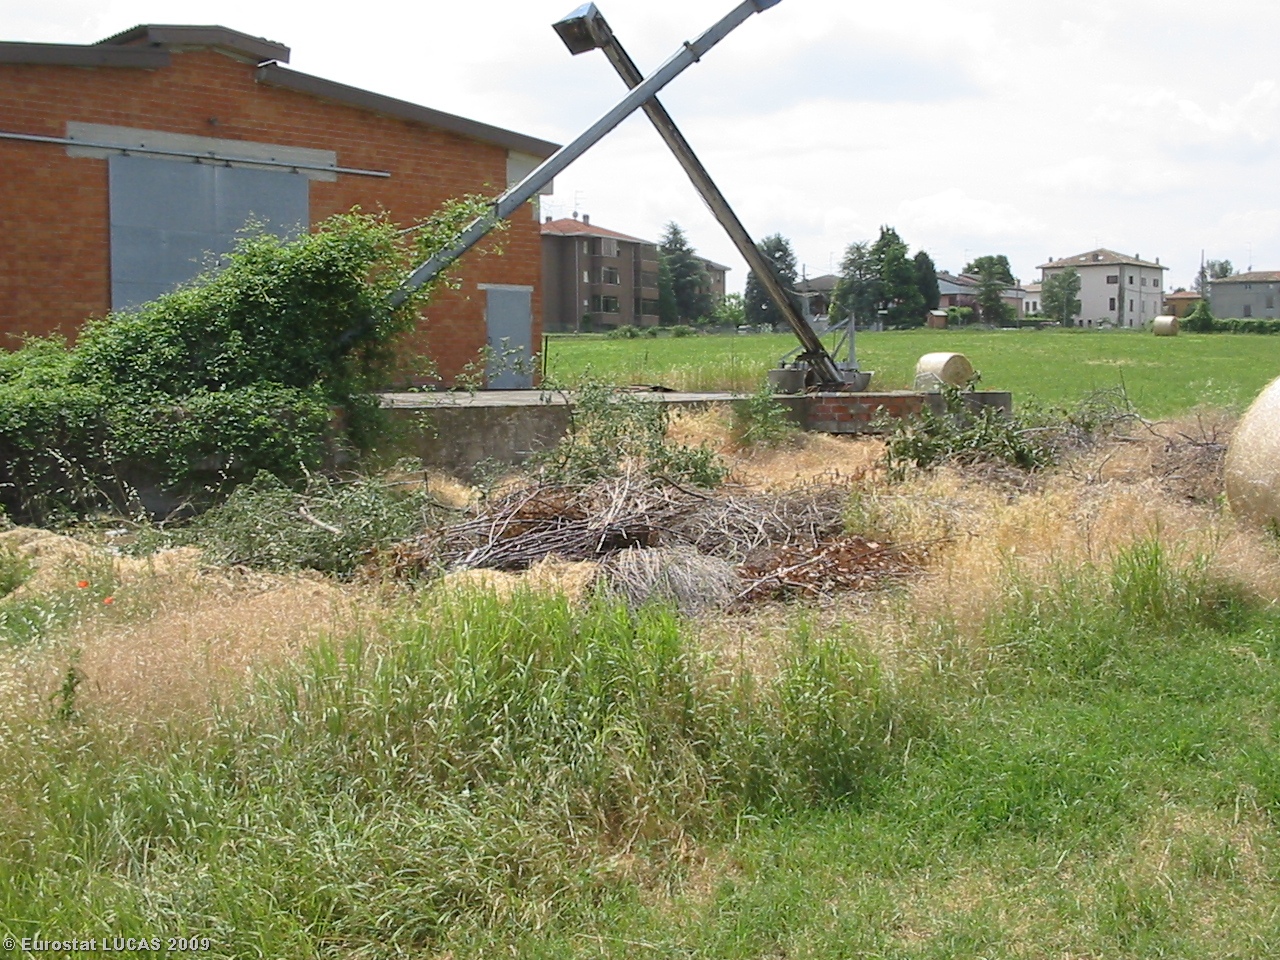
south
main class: Grassland
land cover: Grassland without tree/shrub cover
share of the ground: > 75 %
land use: Agriculture (excluding fallow land and kitchen gardens)
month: June
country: IT
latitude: 44.6746
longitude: 10.3399
